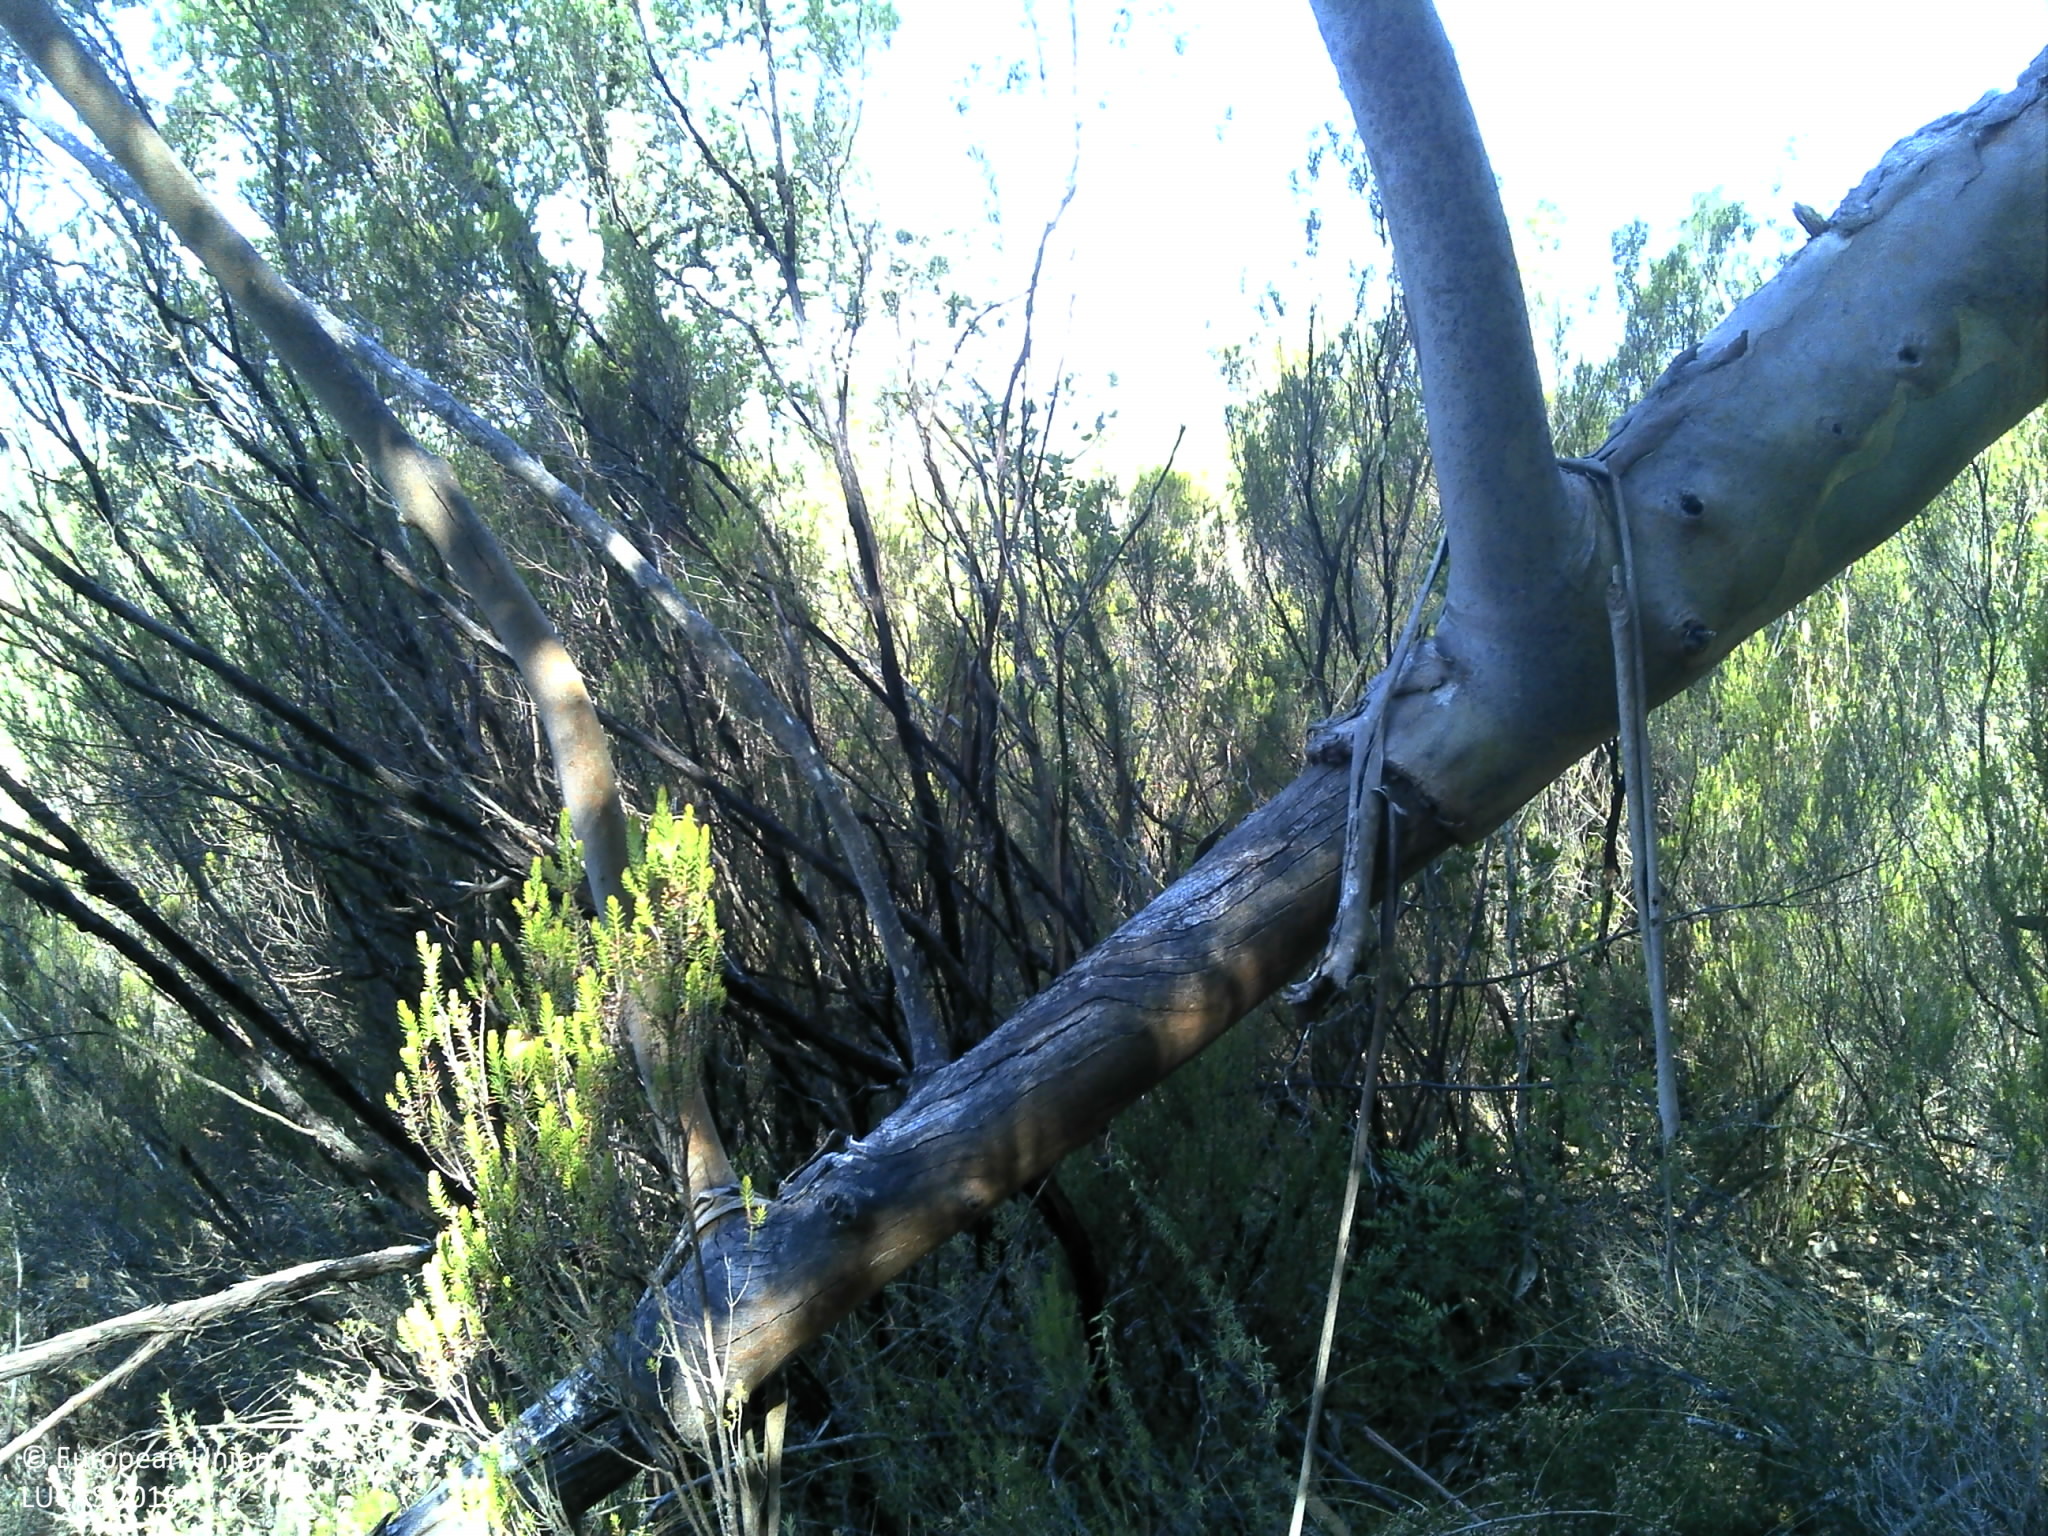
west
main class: Woodland
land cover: Broadleaved woodland
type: exotic forest
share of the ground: 50 - 75 %
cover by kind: broadleaved forest trees 60 %, shrubs 20 %, consolidated bare surface 10 %, unconsolidated bare surface 10 %
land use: Forestry
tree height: > 5 m
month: July
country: PT
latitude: 39.7827
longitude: -8.4192
